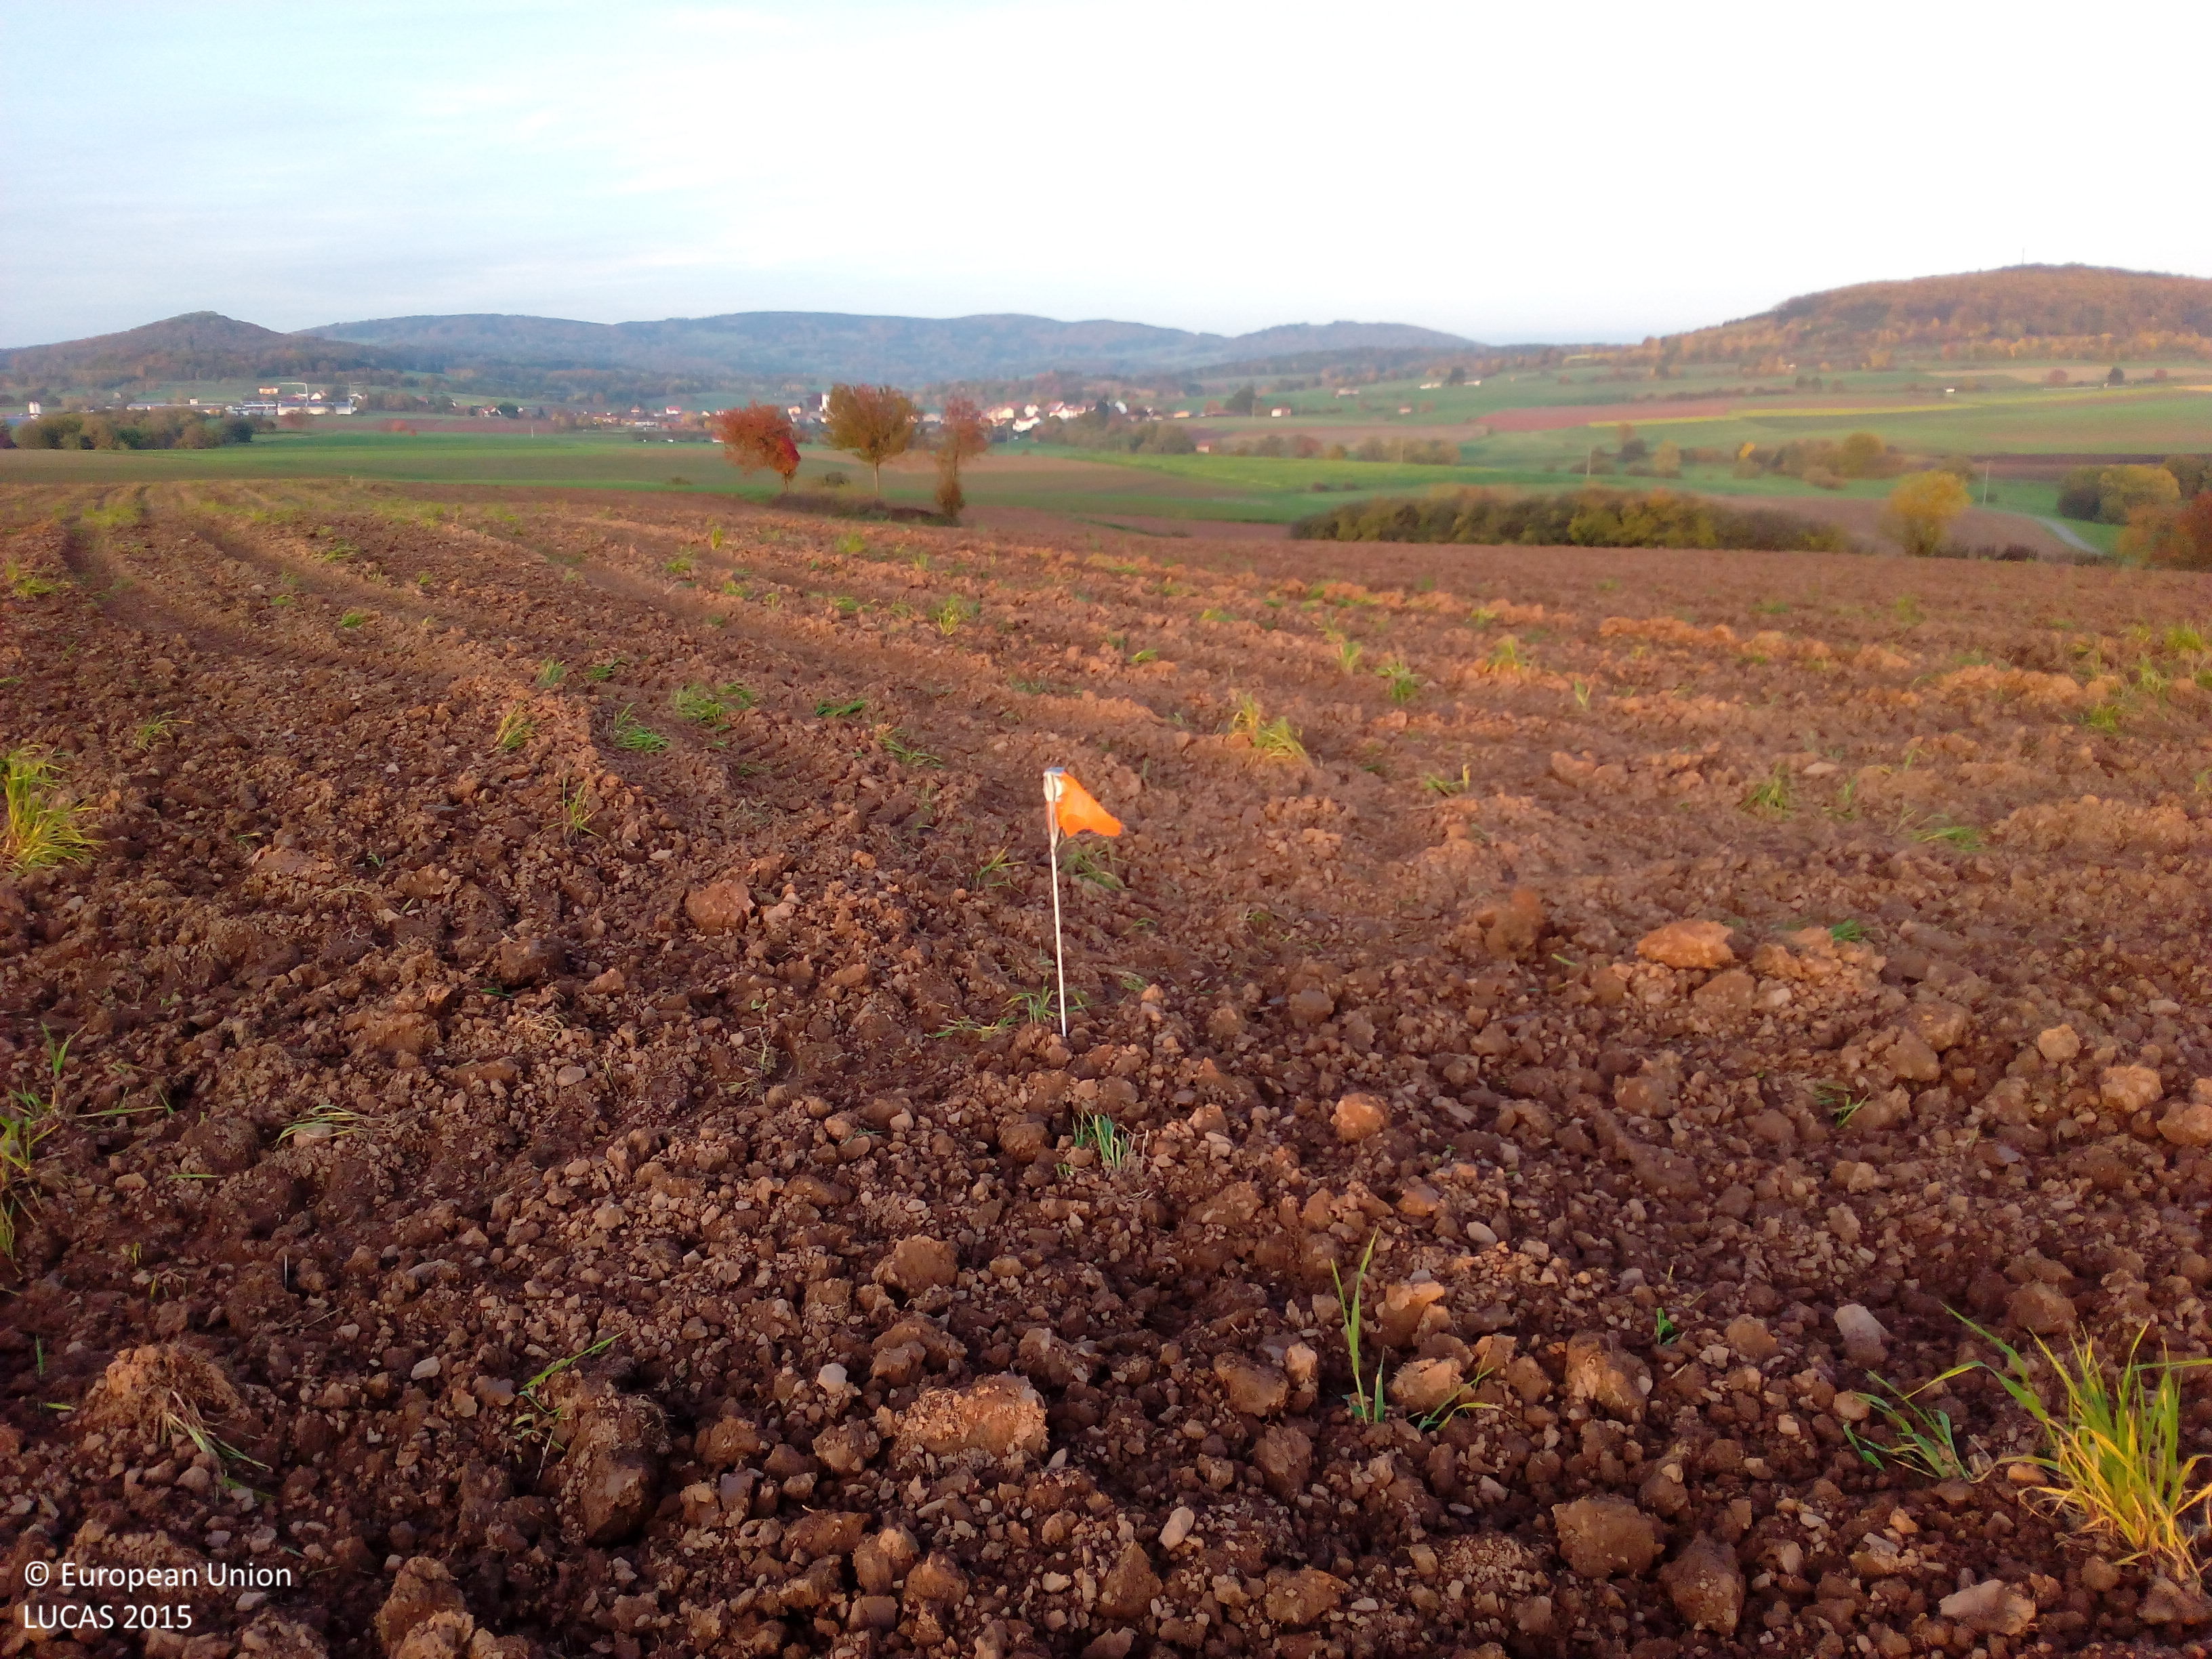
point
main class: Cropland
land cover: Barley
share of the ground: < 10 %
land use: Agriculture (excluding fallow land and kitchen gardens)
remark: Tilled/Sowed
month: October
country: DE
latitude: 50.2561
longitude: 9.8458
